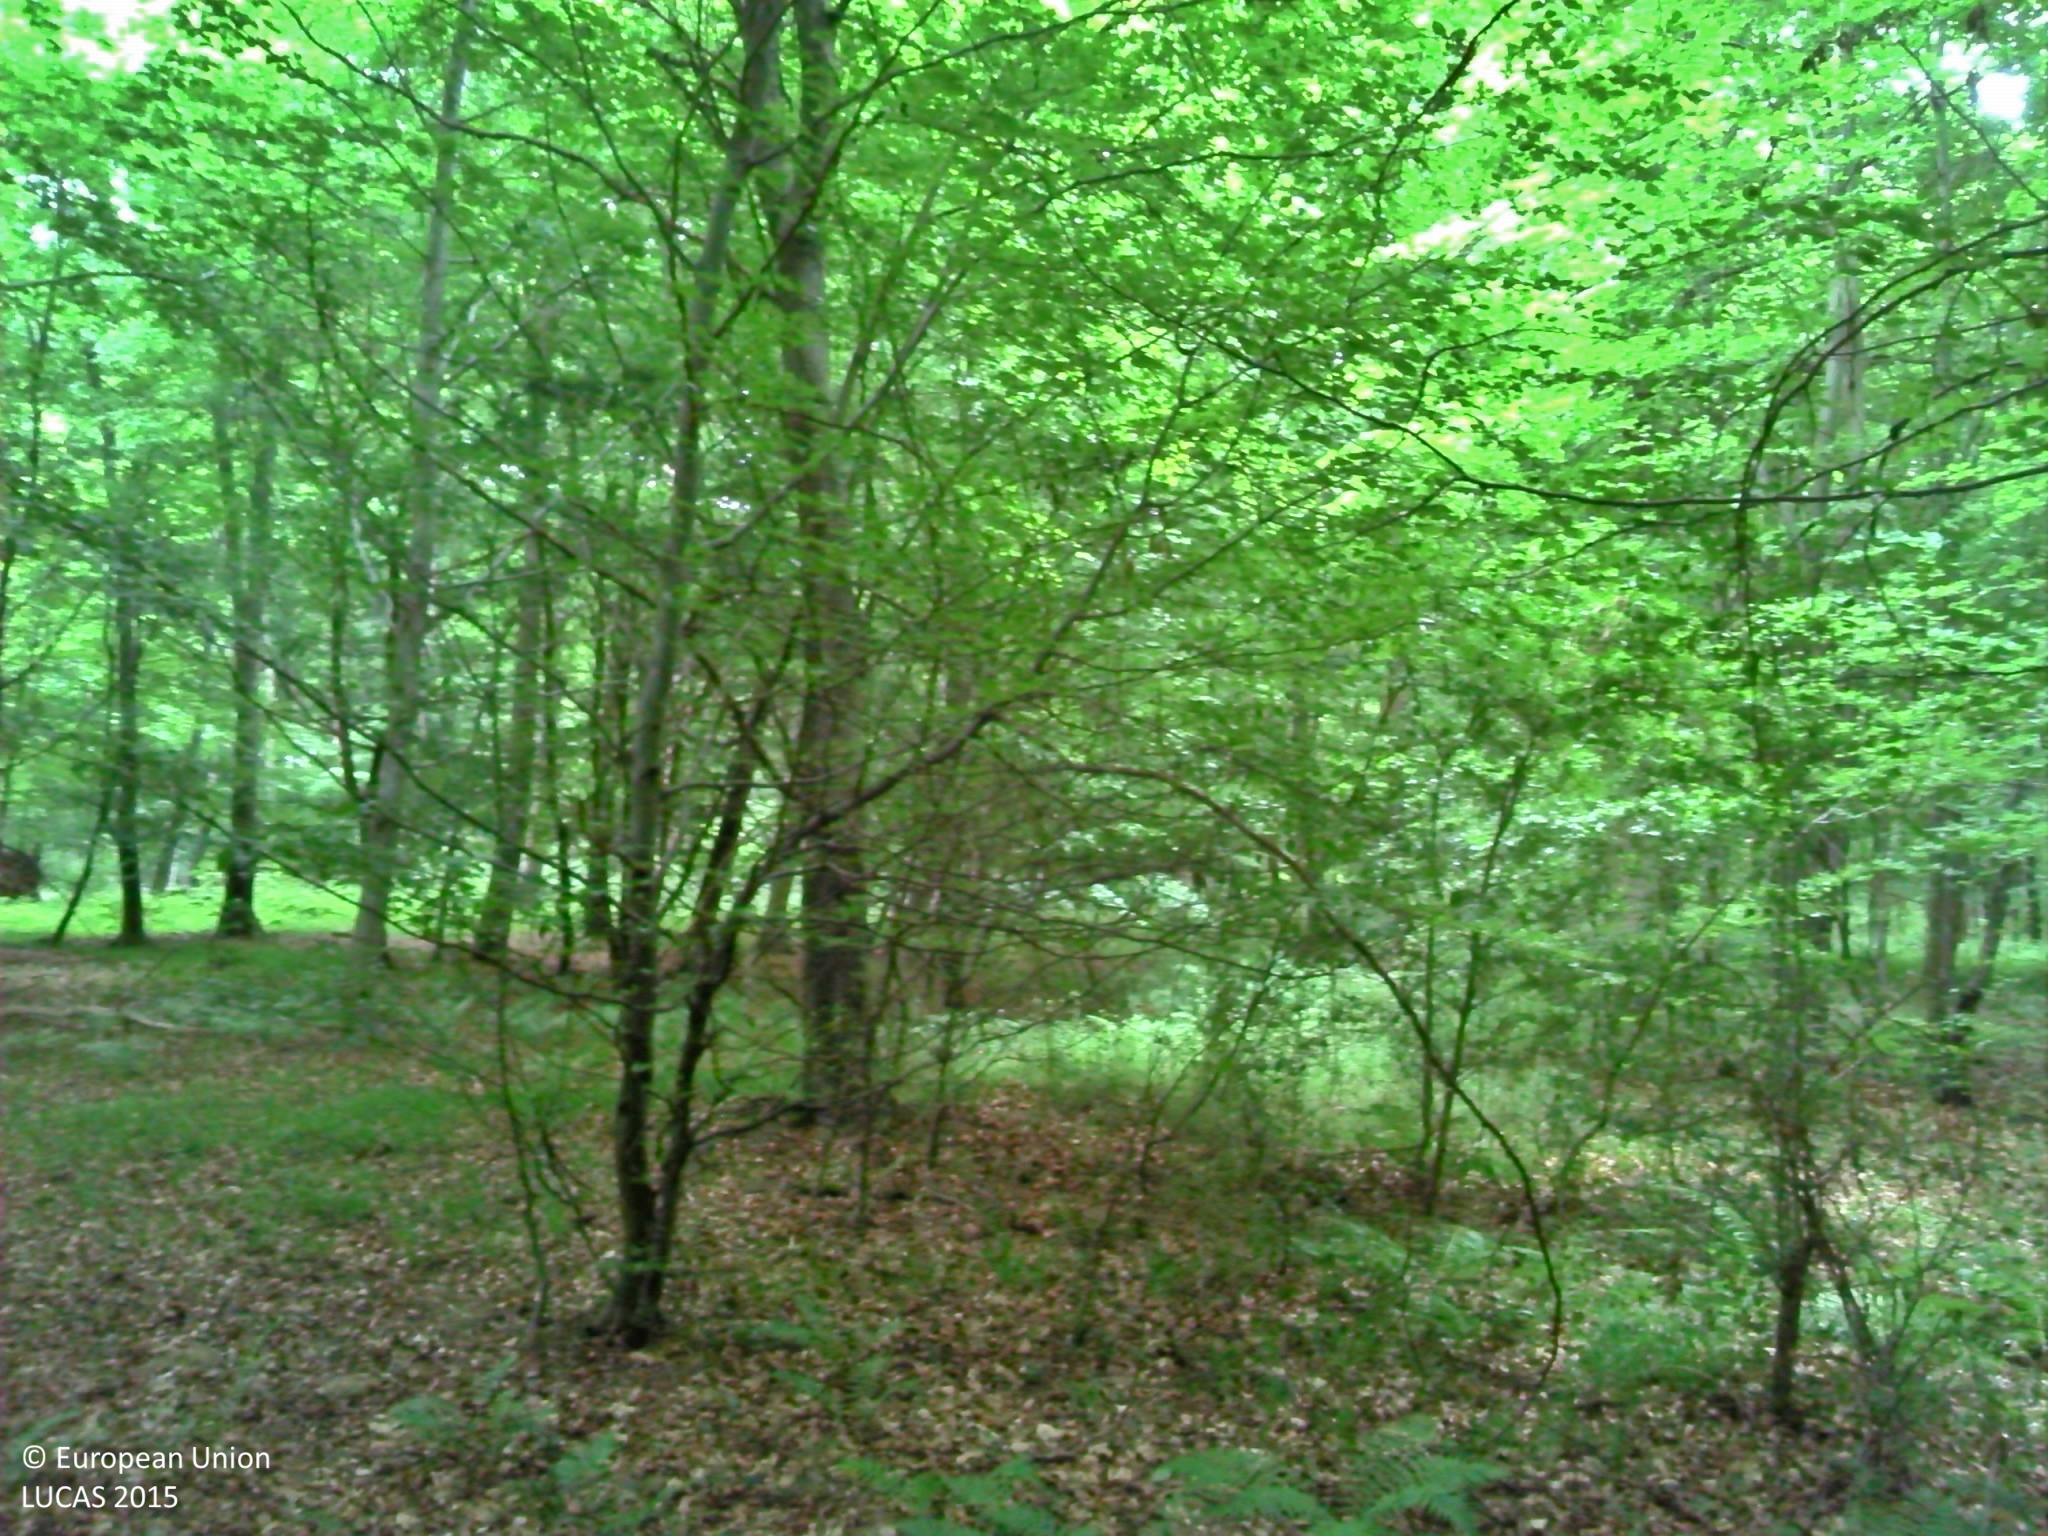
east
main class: Woodland
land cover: Broadleaved woodland
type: beech forest
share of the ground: > 75 %
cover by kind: broadleaved forest trees 90 %, shrubs 5 %, herbaceous plants 5 %
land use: Forestry
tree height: > 5 m
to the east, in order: Broadleaved woodland
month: June
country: FR
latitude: 49.3311
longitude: 2.9036
